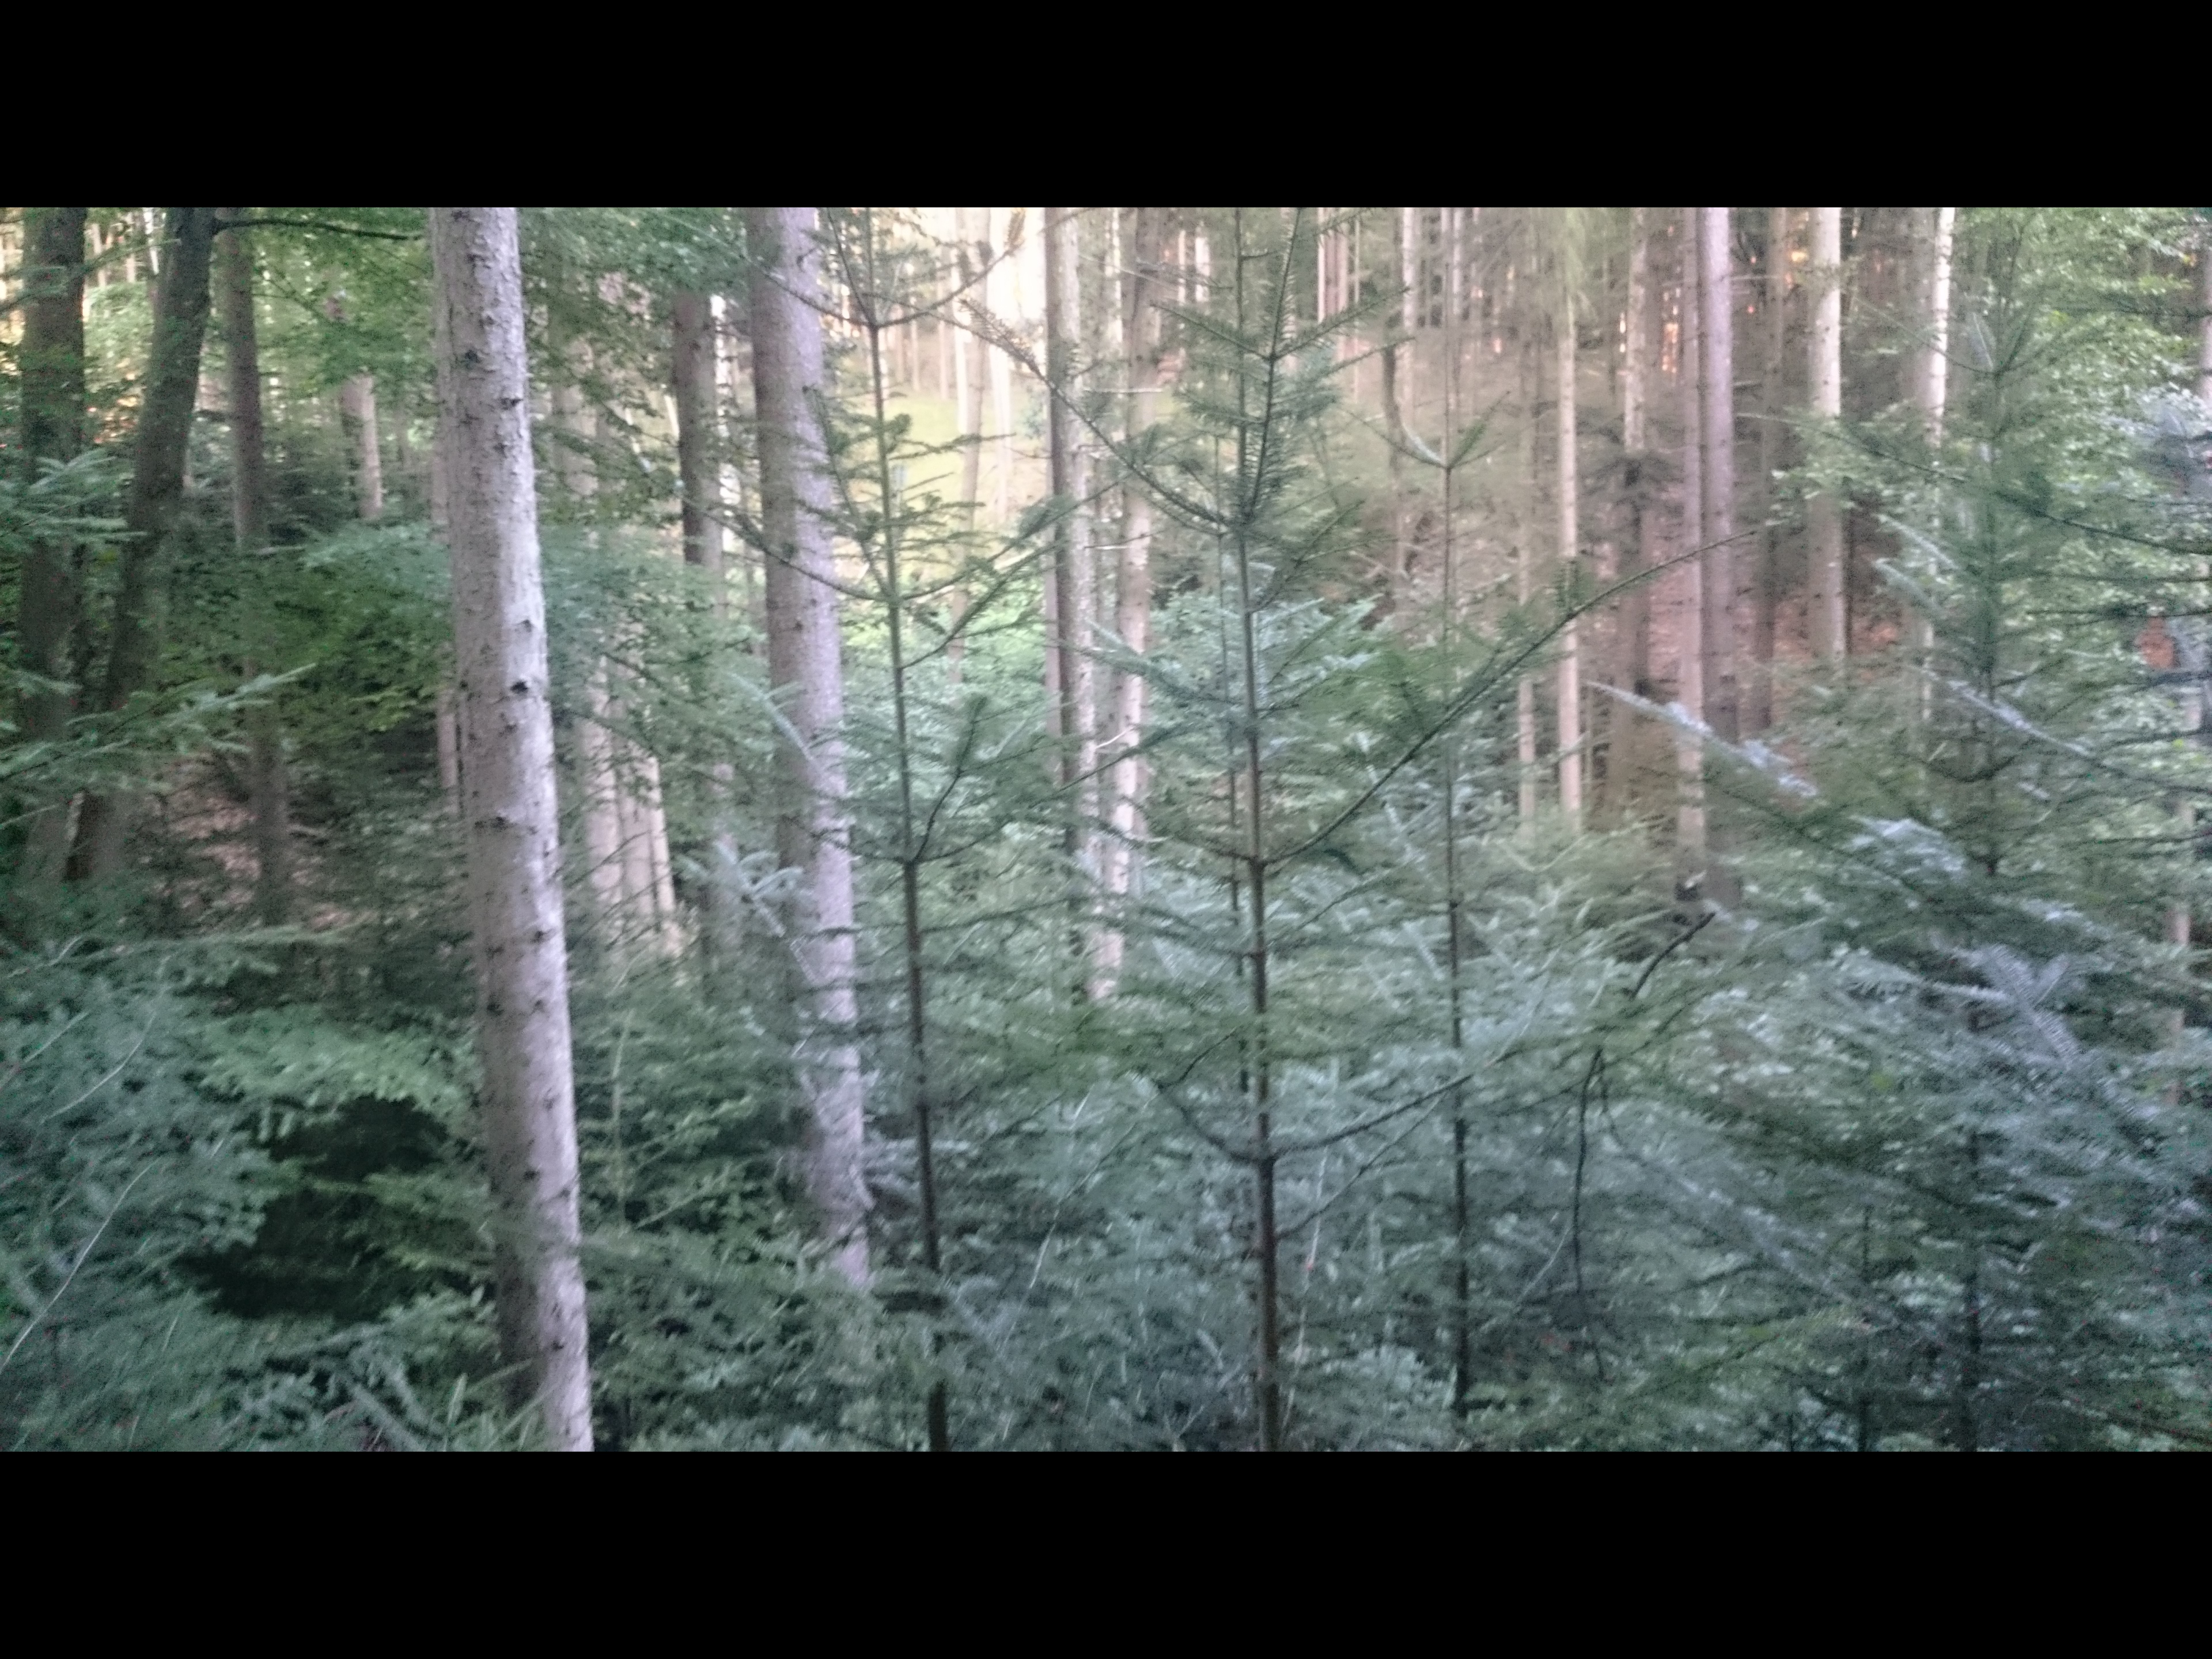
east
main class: Woodland
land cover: Spruce dominated mixed woodland
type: hemiboreal forest and nemoral coniferous forest and mixed broadleaved-coniferous forest
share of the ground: > 75 %
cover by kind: coniferous forest trees 75 %, broadleaved forest trees 25 %
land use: Forestry
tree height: > 5 m
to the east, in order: Spruce dominated mixed woodland; Rivers and streams; Spruce dominated mixed woodland; Tracks; Spruce dominated mixed woodland; Tracks; Pine dominated mixed woodland; Tracks; Pine dominated mixed woodland
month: July
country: AT
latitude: 47.2823
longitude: 15.6991
